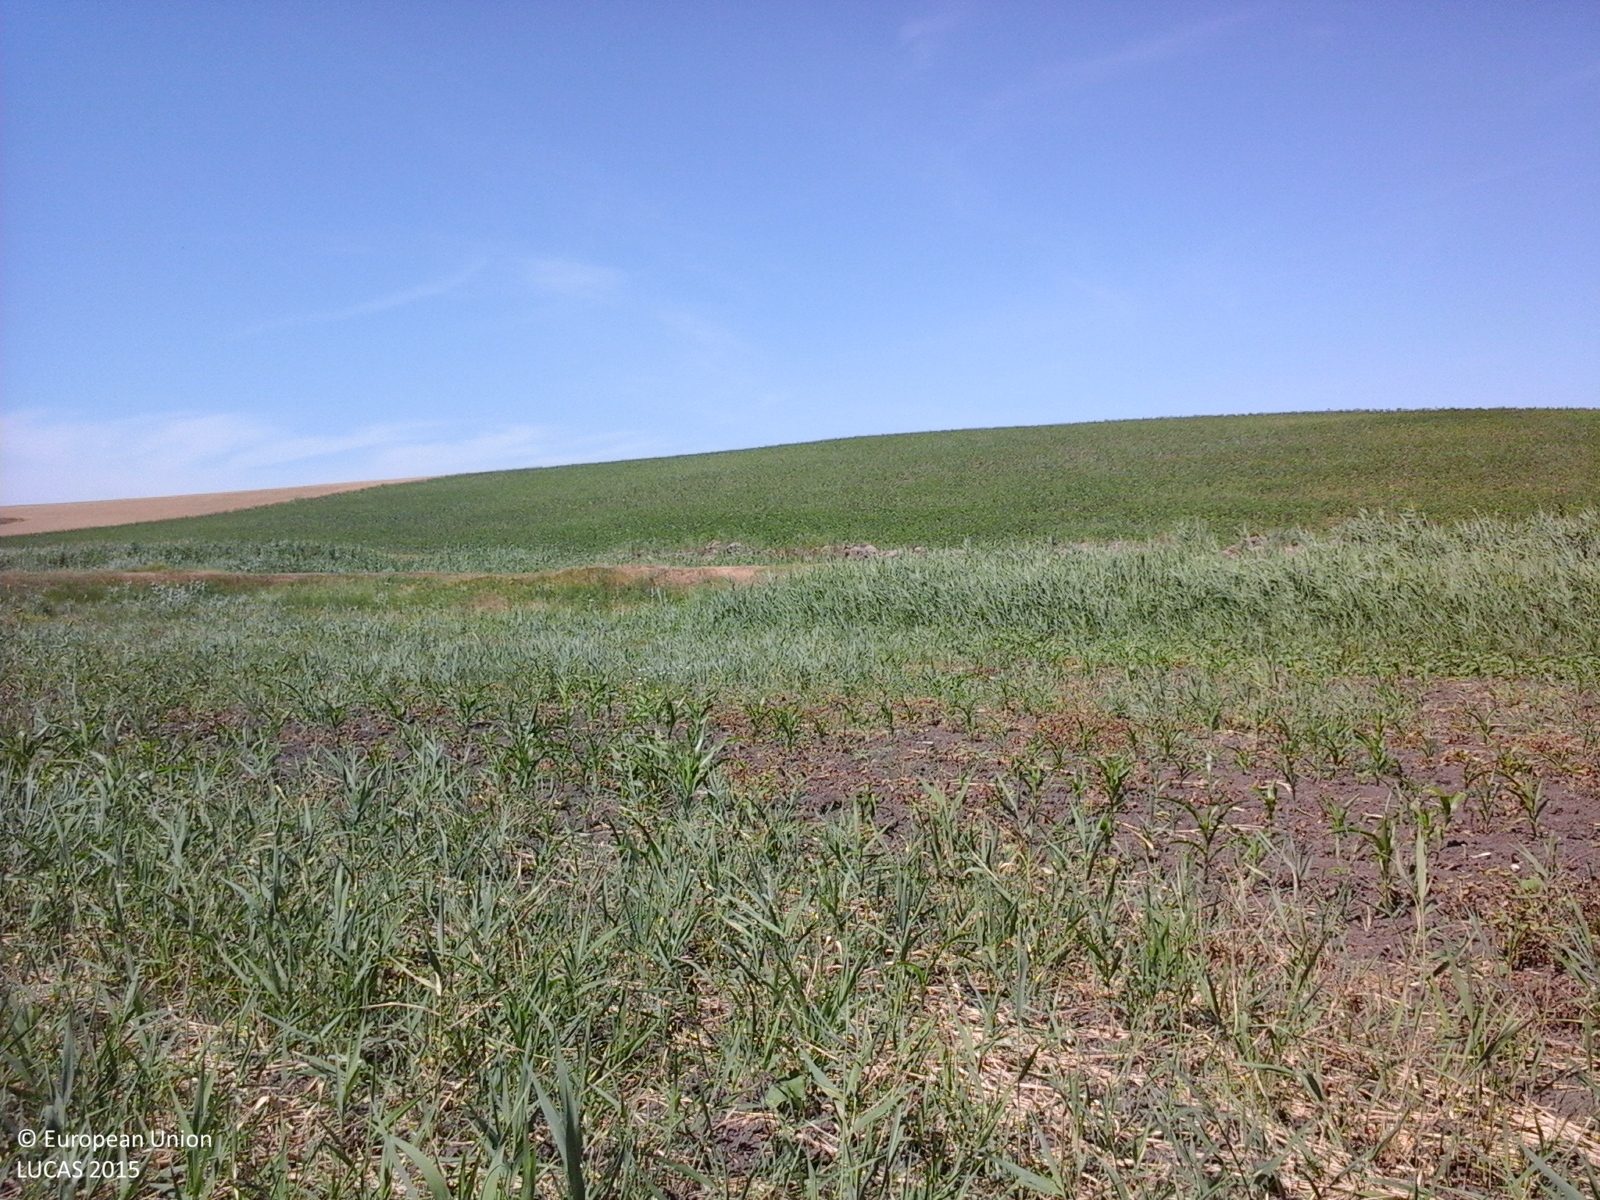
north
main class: Grassland
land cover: Spontaneously vegetated surfaces
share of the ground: > 75 %
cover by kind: herbaceous plants 100 %
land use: Agriculture (excluding fallow land and kitchen gardens)
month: June
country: RO
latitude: 47.2533
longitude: 27.0289
